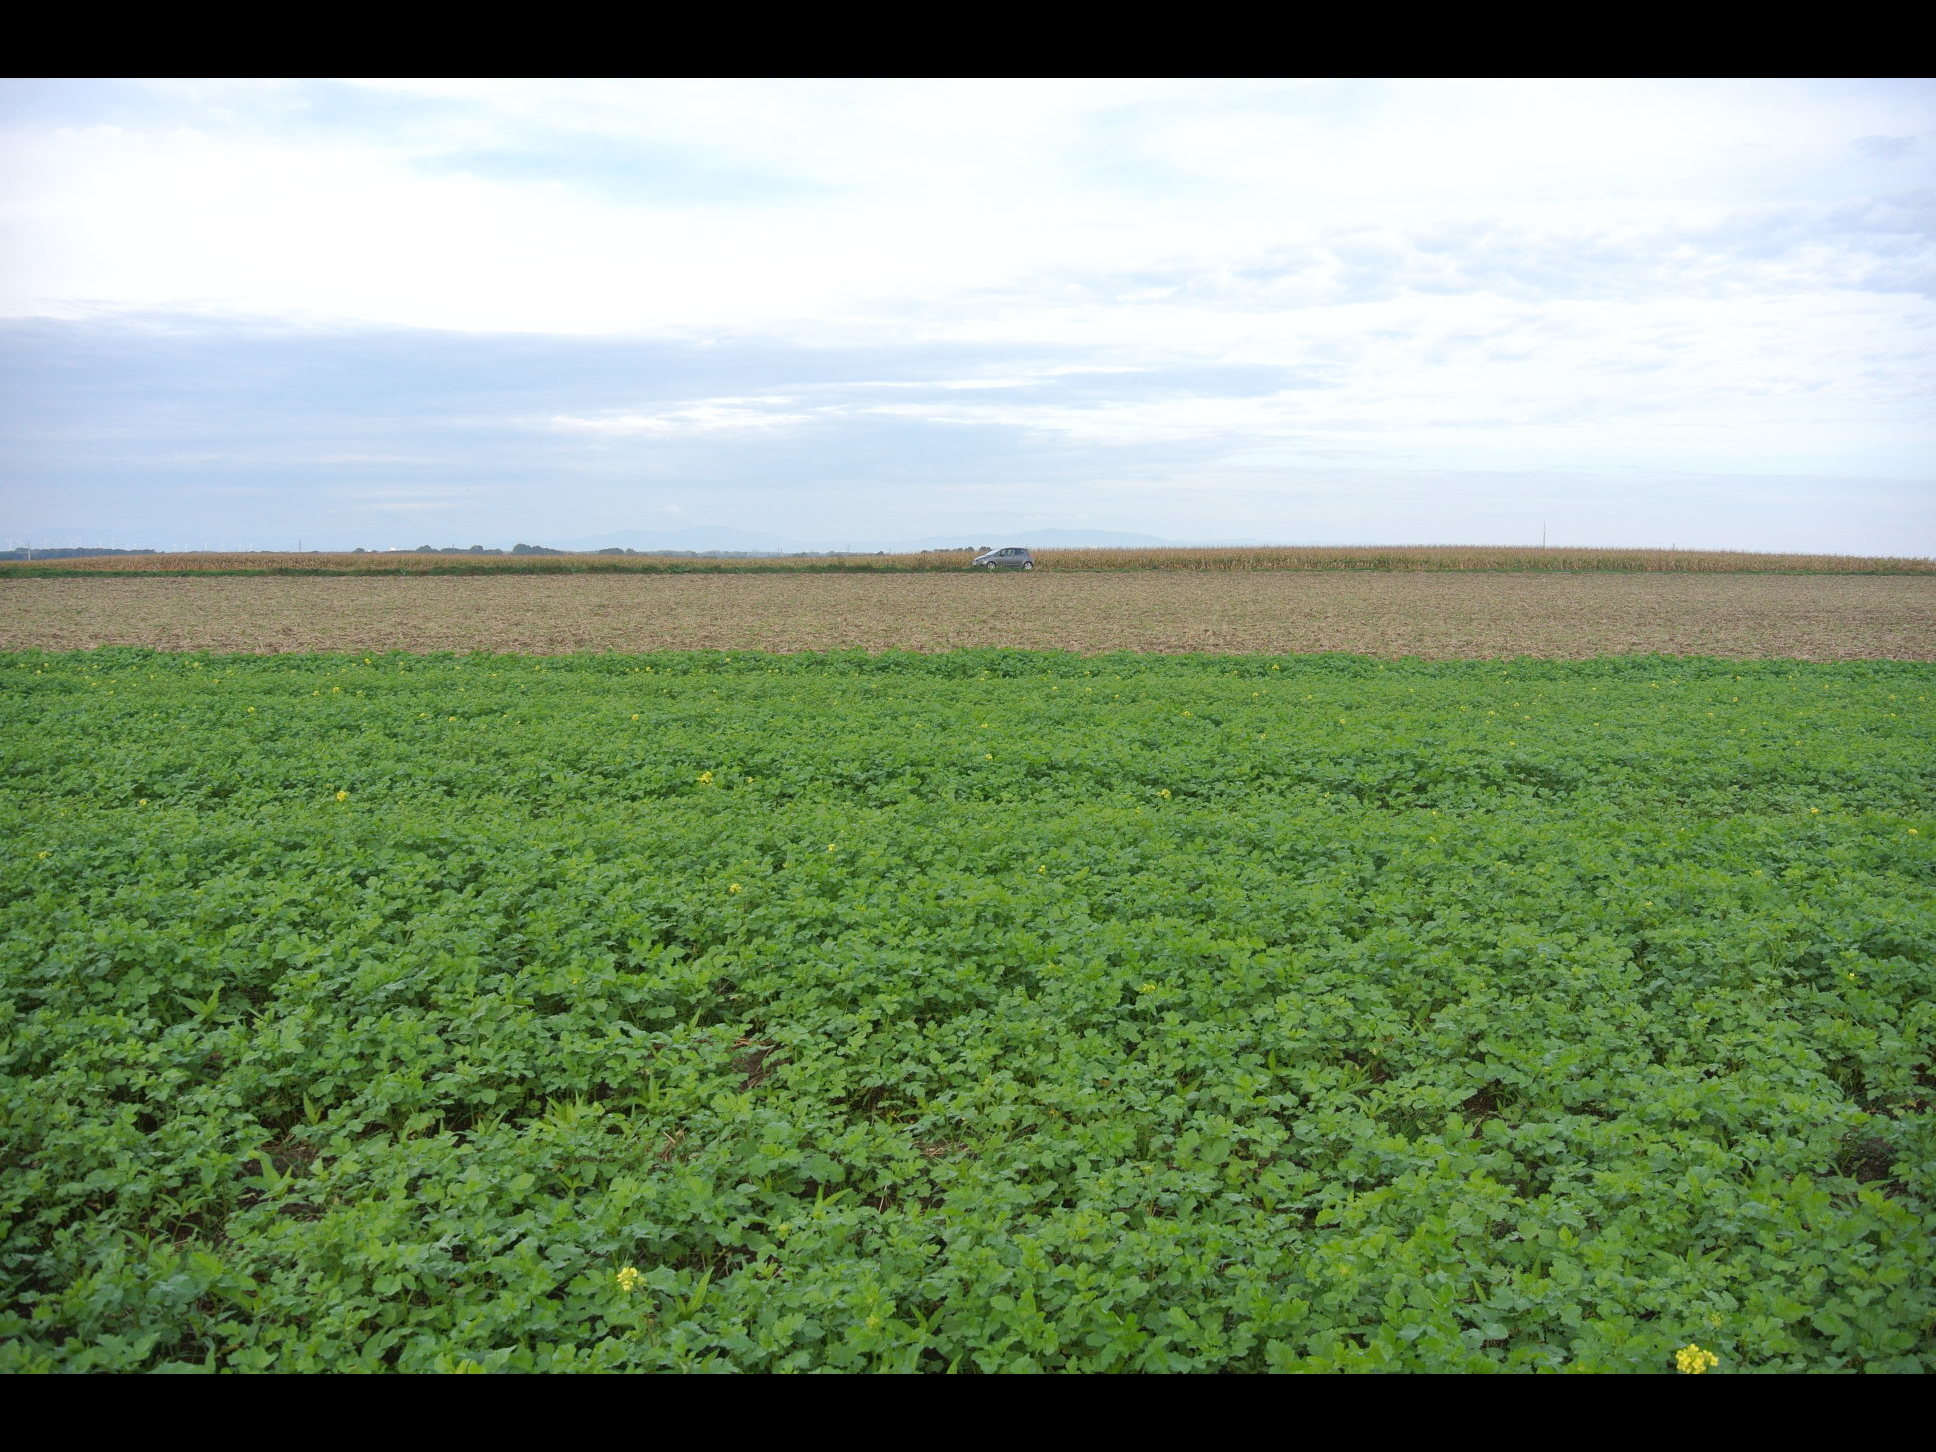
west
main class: Cropland
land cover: Rape and turnip rape
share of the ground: > 75 %
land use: Agriculture (excluding fallow land and kitchen gardens)
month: May
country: AT
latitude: 47.9726
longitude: 16.5825
